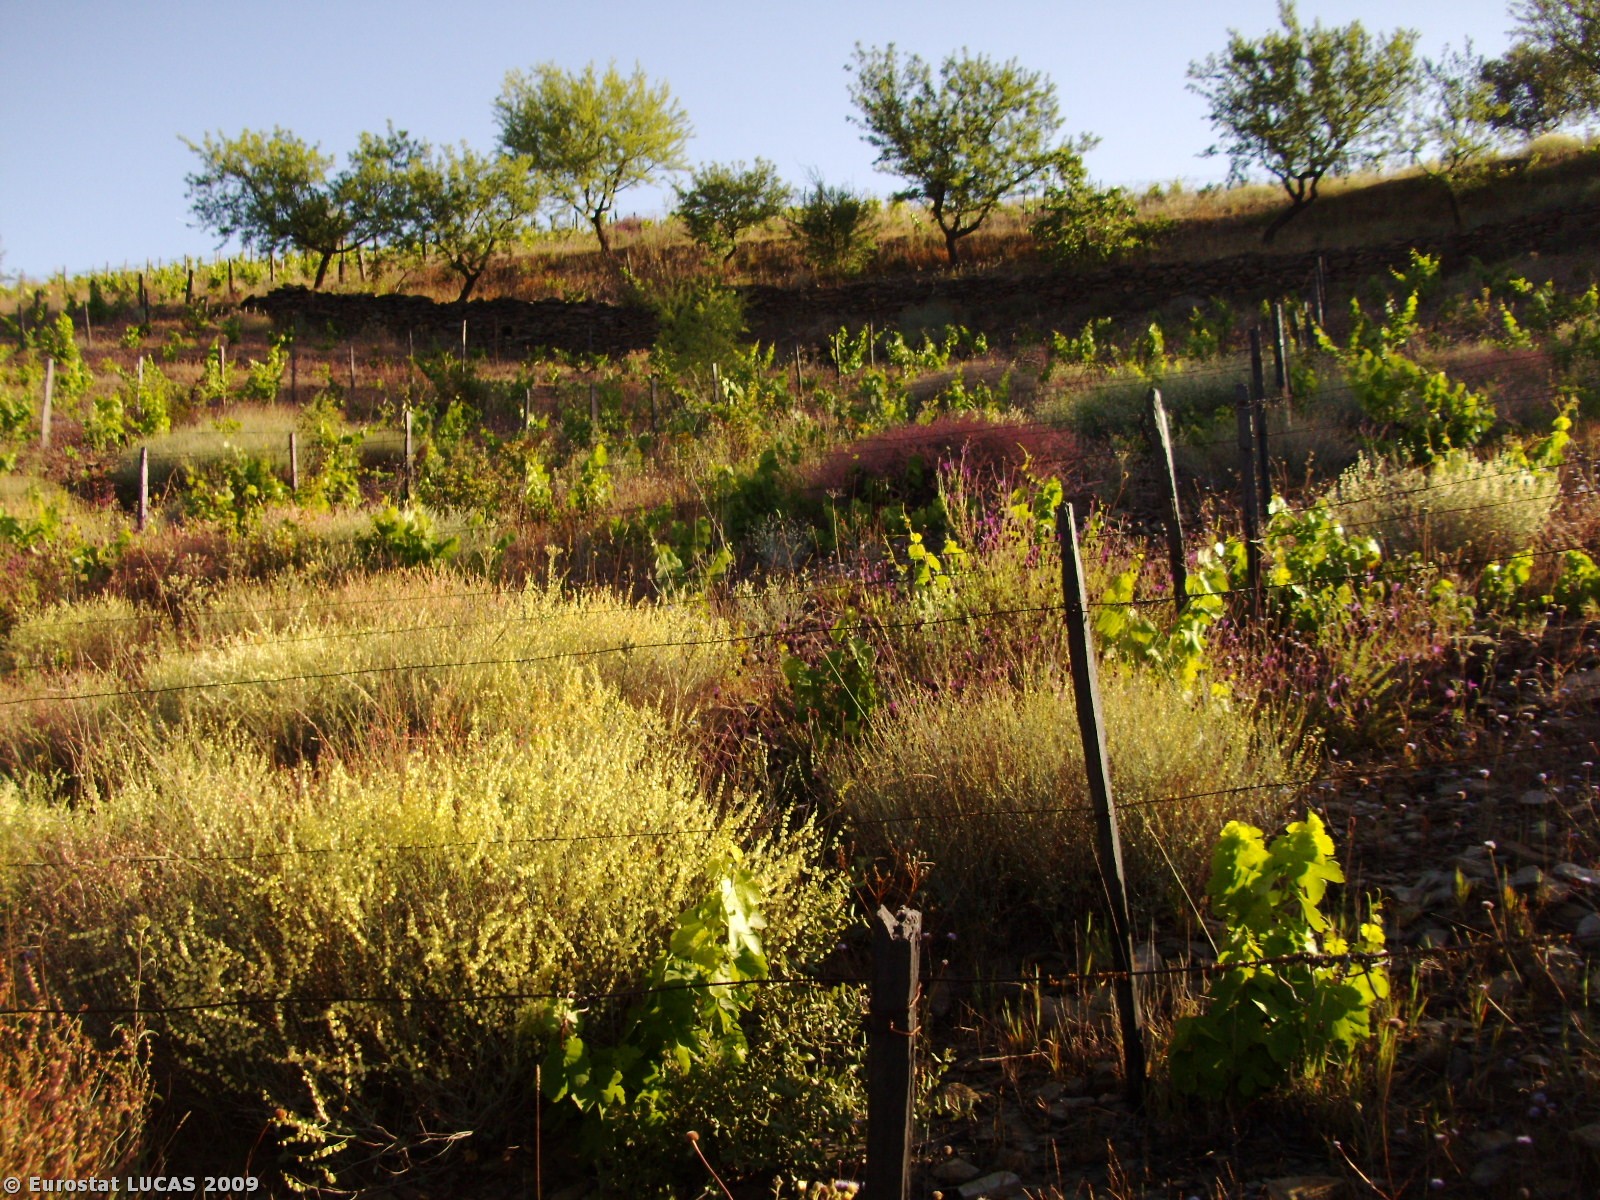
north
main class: Shrubland
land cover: Shrubland without tree cover
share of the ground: > 75 %
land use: Unused
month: May
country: PT
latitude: 41.0984
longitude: -7.3941
